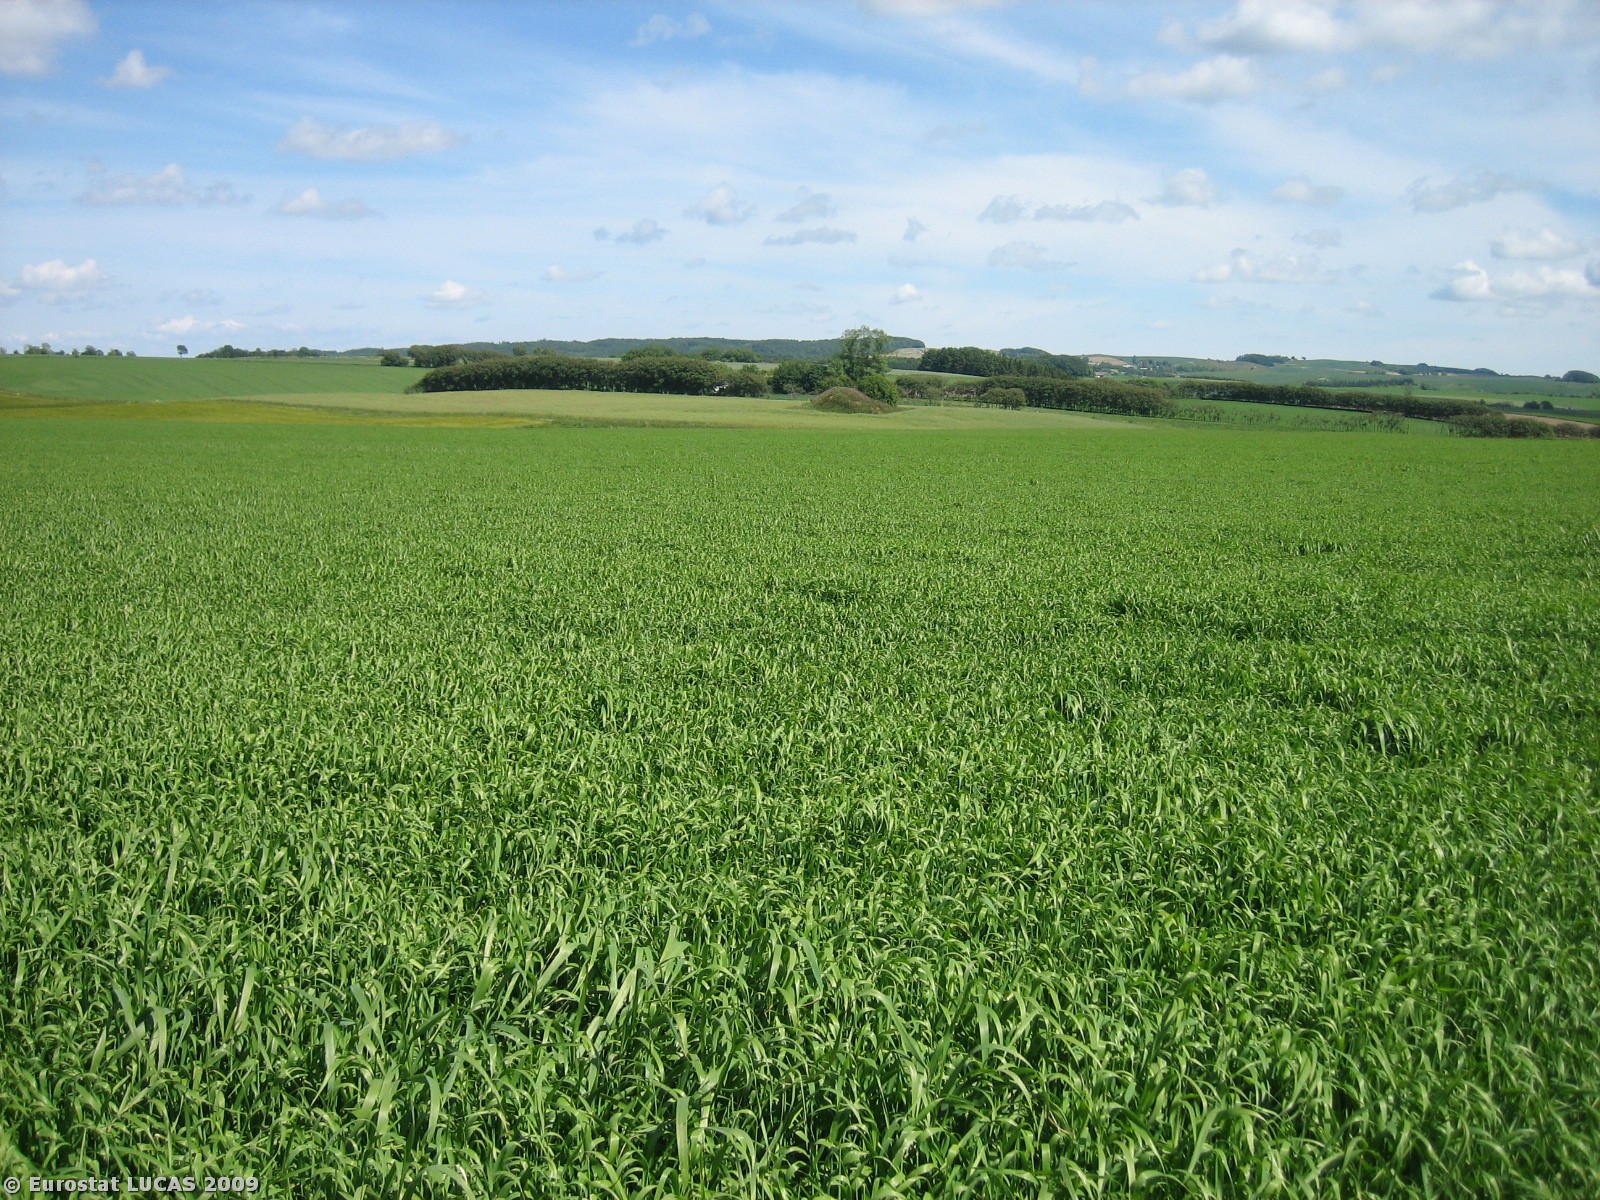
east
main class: Cropland
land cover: Barley
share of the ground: > 75 %
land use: Agriculture (excluding fallow land and kitchen gardens)
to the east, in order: Barley; Temporary grasslands
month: June
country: DK
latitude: 55.9897
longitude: 9.7278
